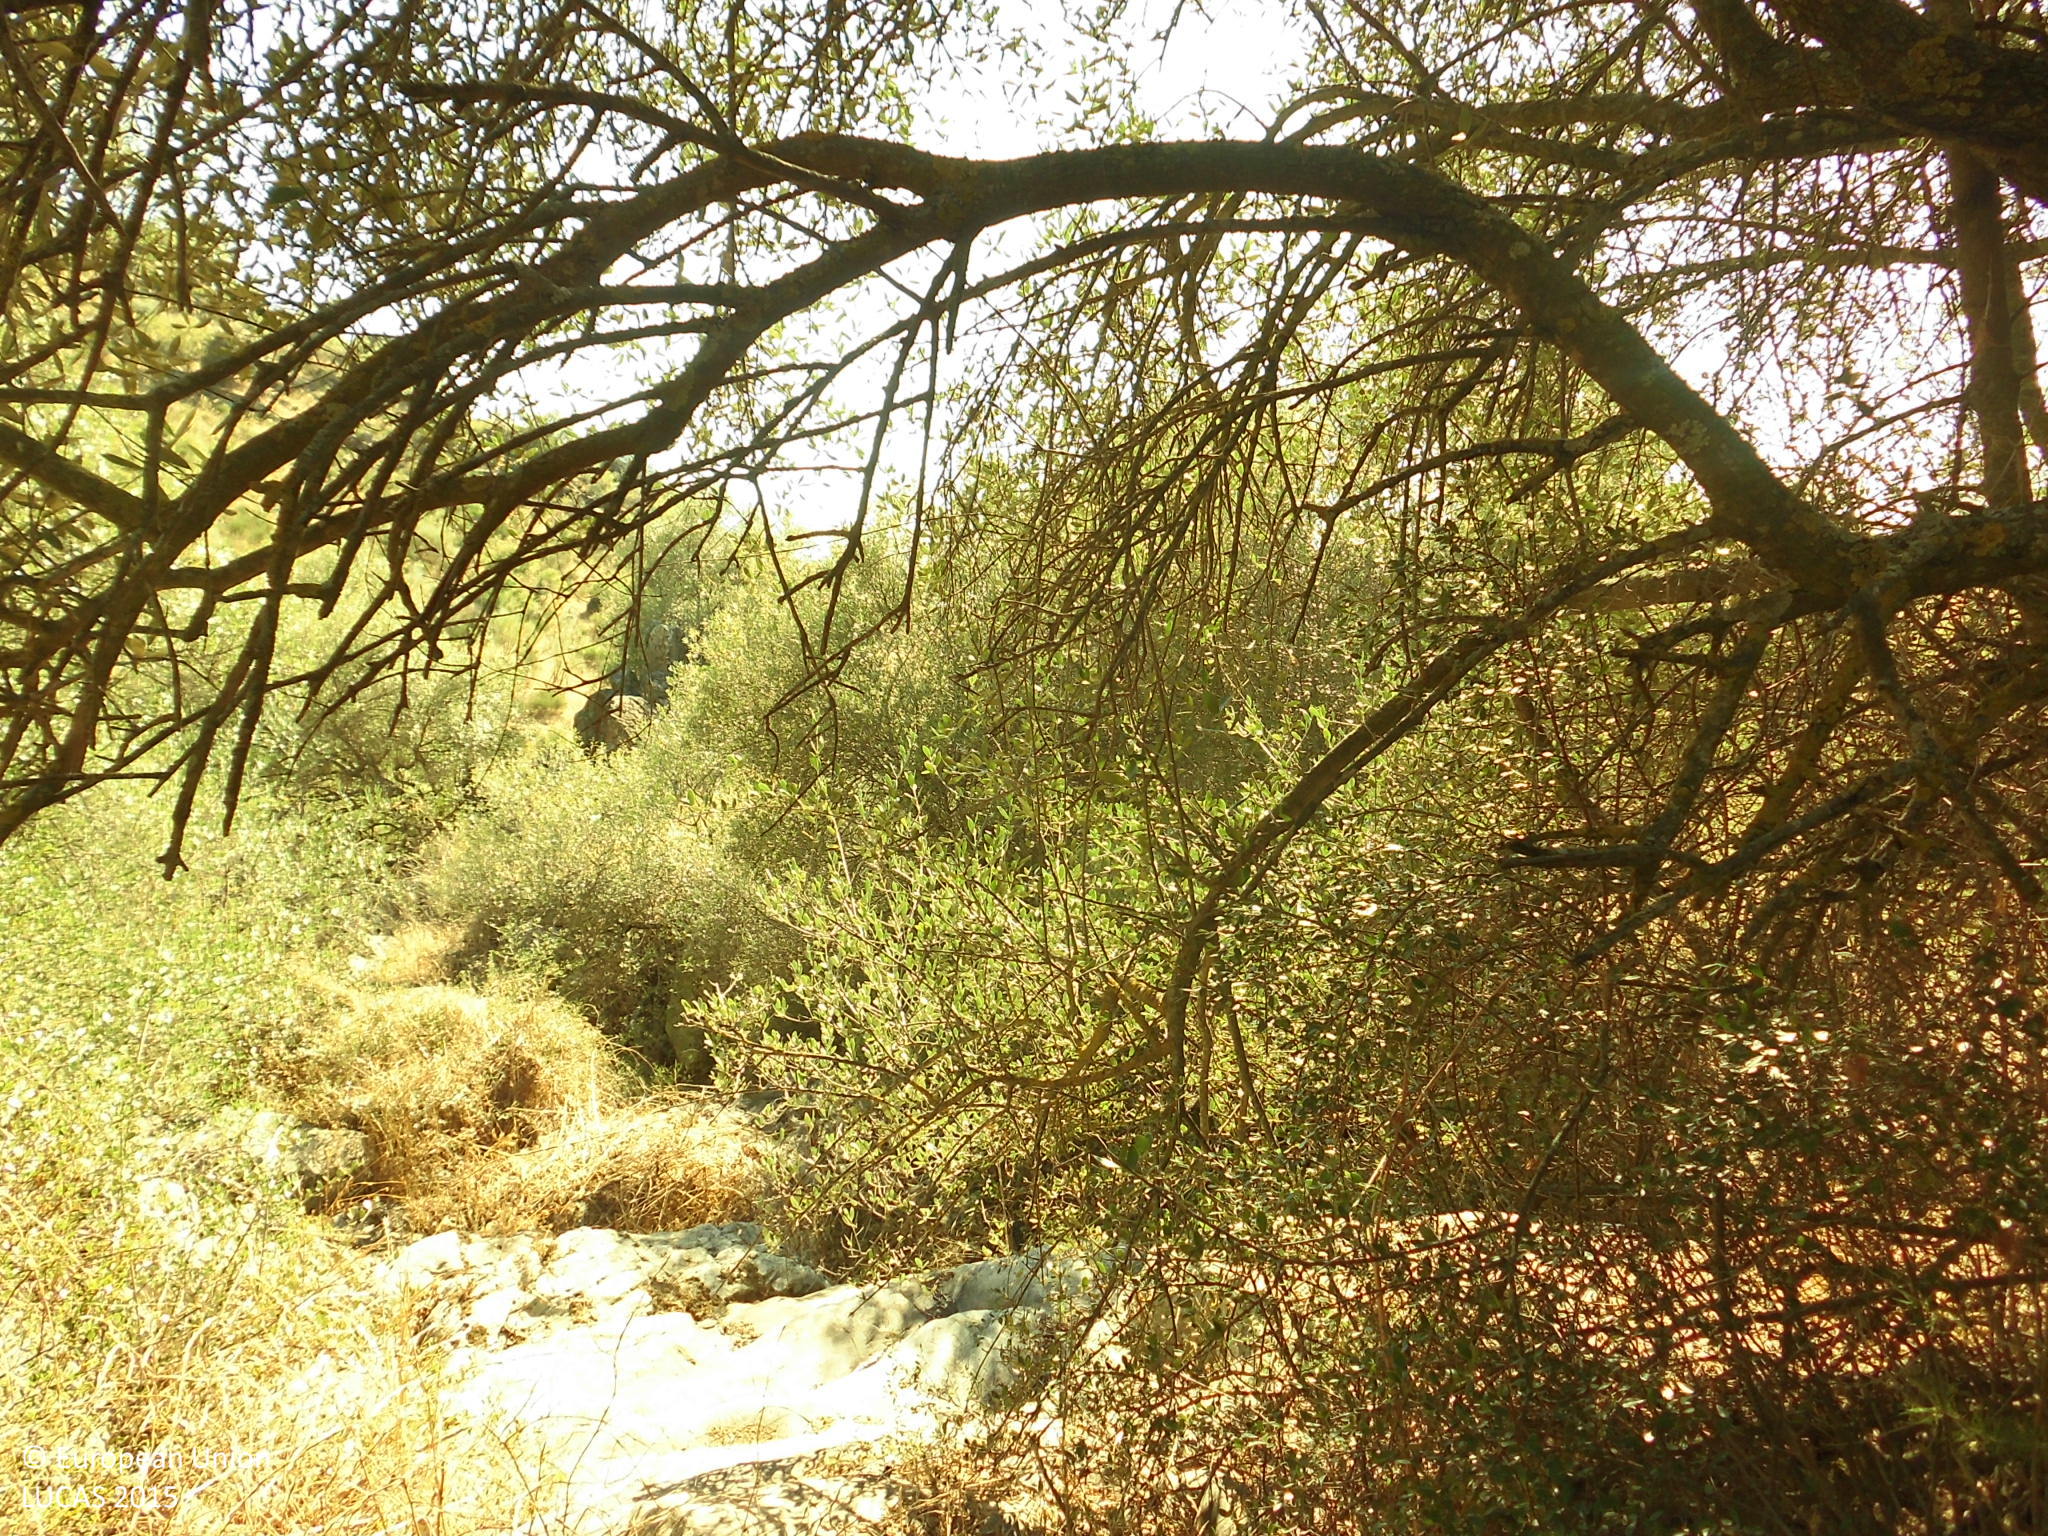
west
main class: Woodland
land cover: Broadleaved woodland
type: thermophilous deciduous forest
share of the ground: 25 - 50 %
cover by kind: broadleaved forest trees 50 %, shrubs 40 %, herbaceous plants 10 %
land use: Semi-natural and natural areas not in use
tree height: > 5 m
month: June
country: ES
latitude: 39.7347
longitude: -6.4444
